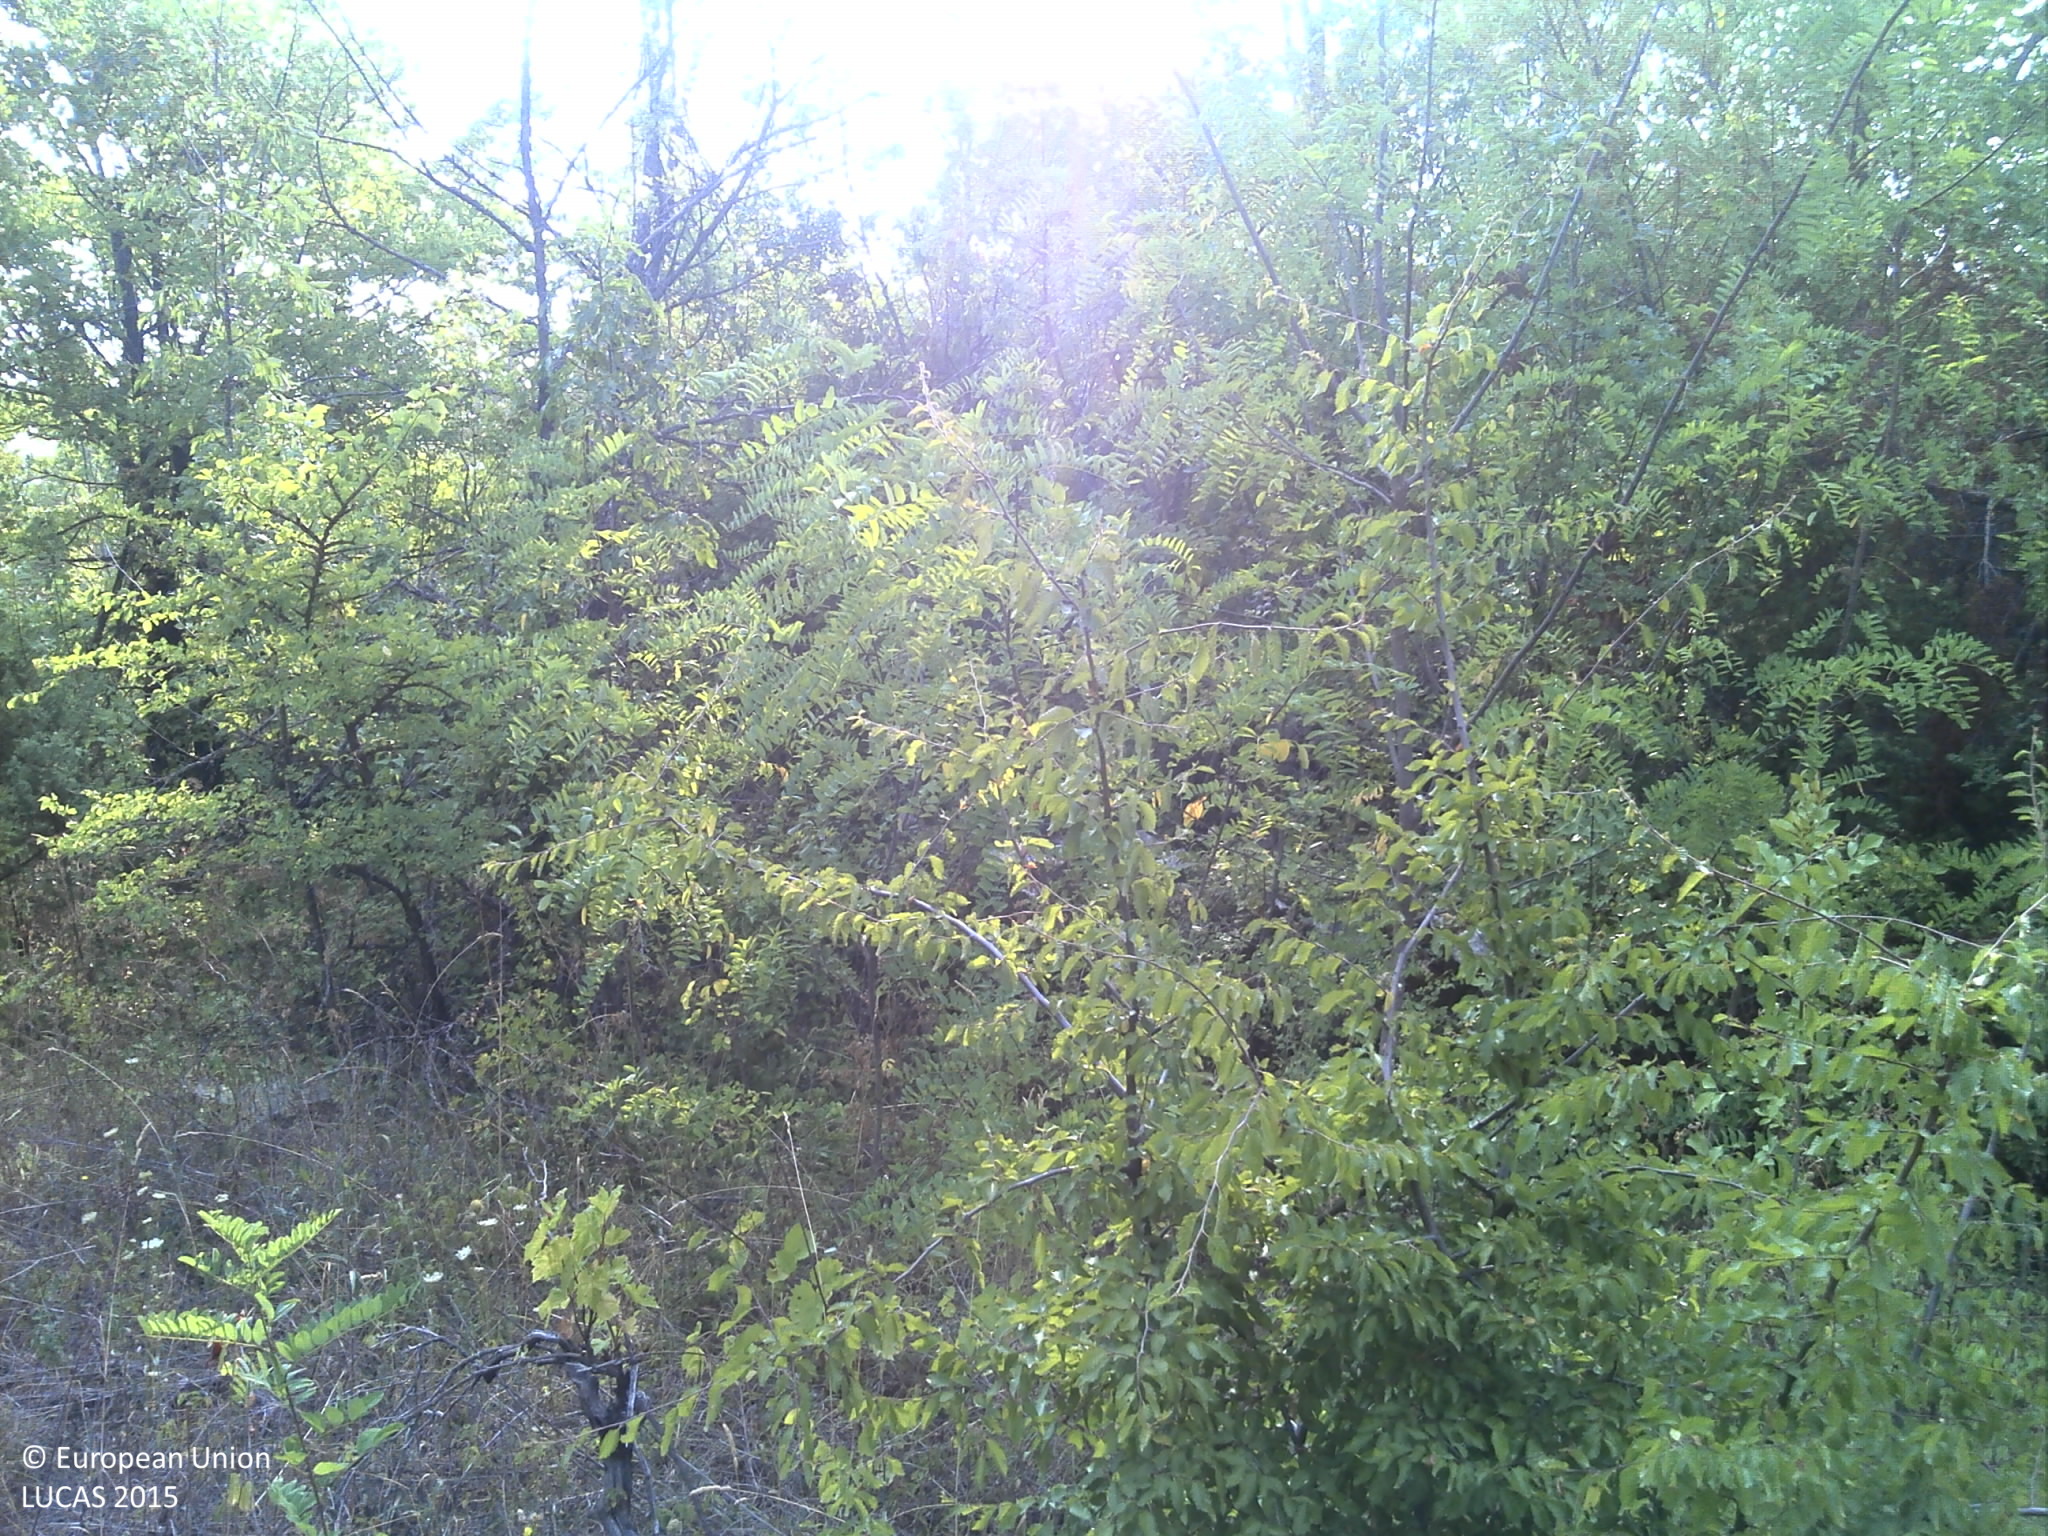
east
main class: Grassland
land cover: Grassland with sparse tree/shrub cover
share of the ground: > 75 %
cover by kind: herbaceous plants 80 %, shrubs 10 %, broadleaved forest trees 5 %, consolidated bare surface 5 %
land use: Abandoned areas
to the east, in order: Grassland with sparse tree/shrub cover; Shrubland with sparse tree cover; Dry stone walls; Shrubland with sparse tree cover; Tracks; Shrubland with sparse tree cover; Dry stone walls; Shrubland with sparse tree cover; Grassland with sparse tree/shrub cover; Shrubland with sparse tree cover; Electric lines; Shrubland with sparse tree cover
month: August
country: HR
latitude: 43.2281
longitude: 17.2430
